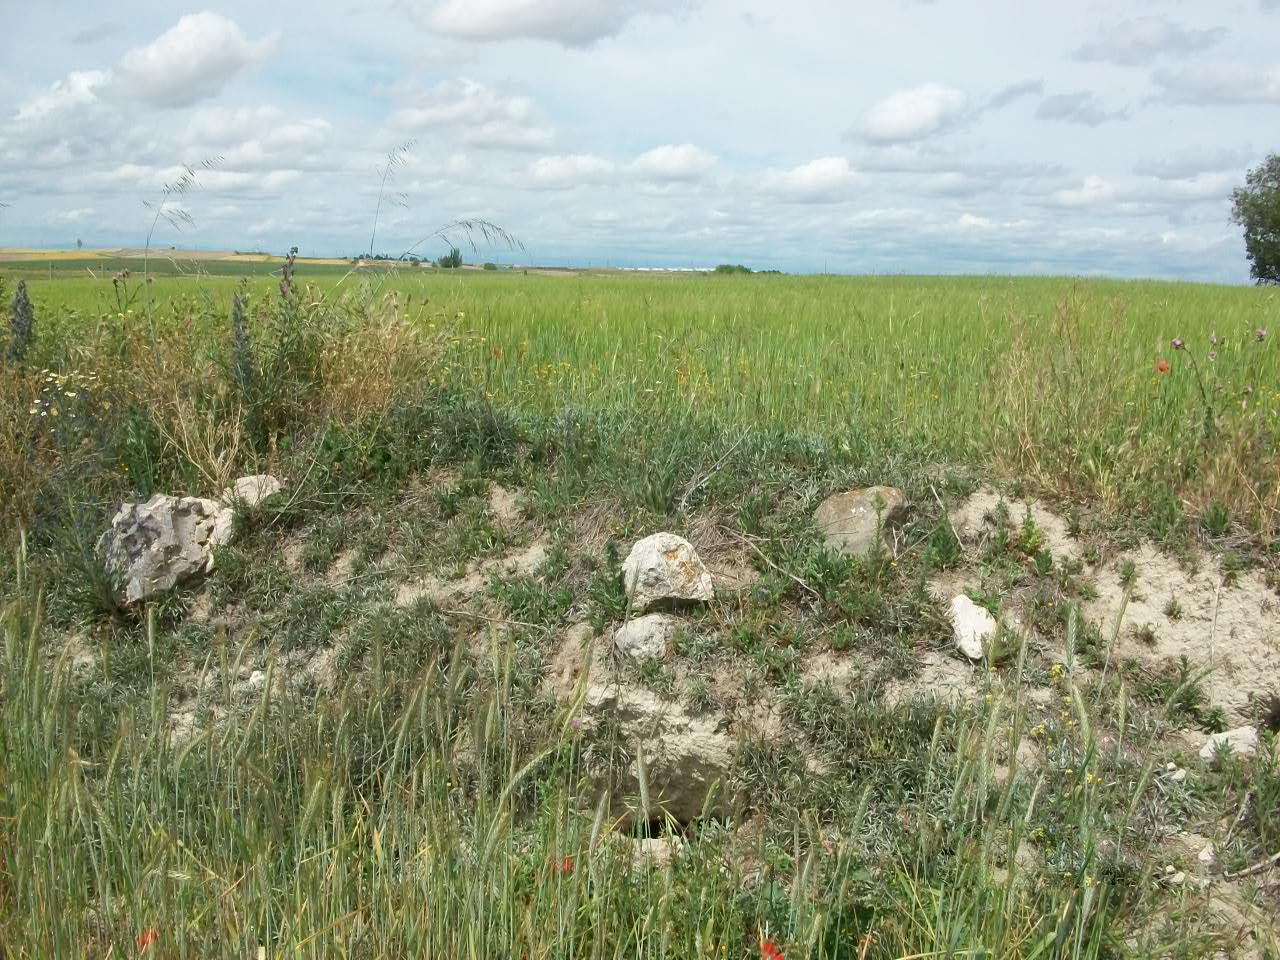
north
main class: Cropland
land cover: Mixed cereals for fodder
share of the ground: > 75 %
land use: Agriculture (excluding fallow land and kitchen gardens)
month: May
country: ES
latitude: 40.1541
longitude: -3.7585
